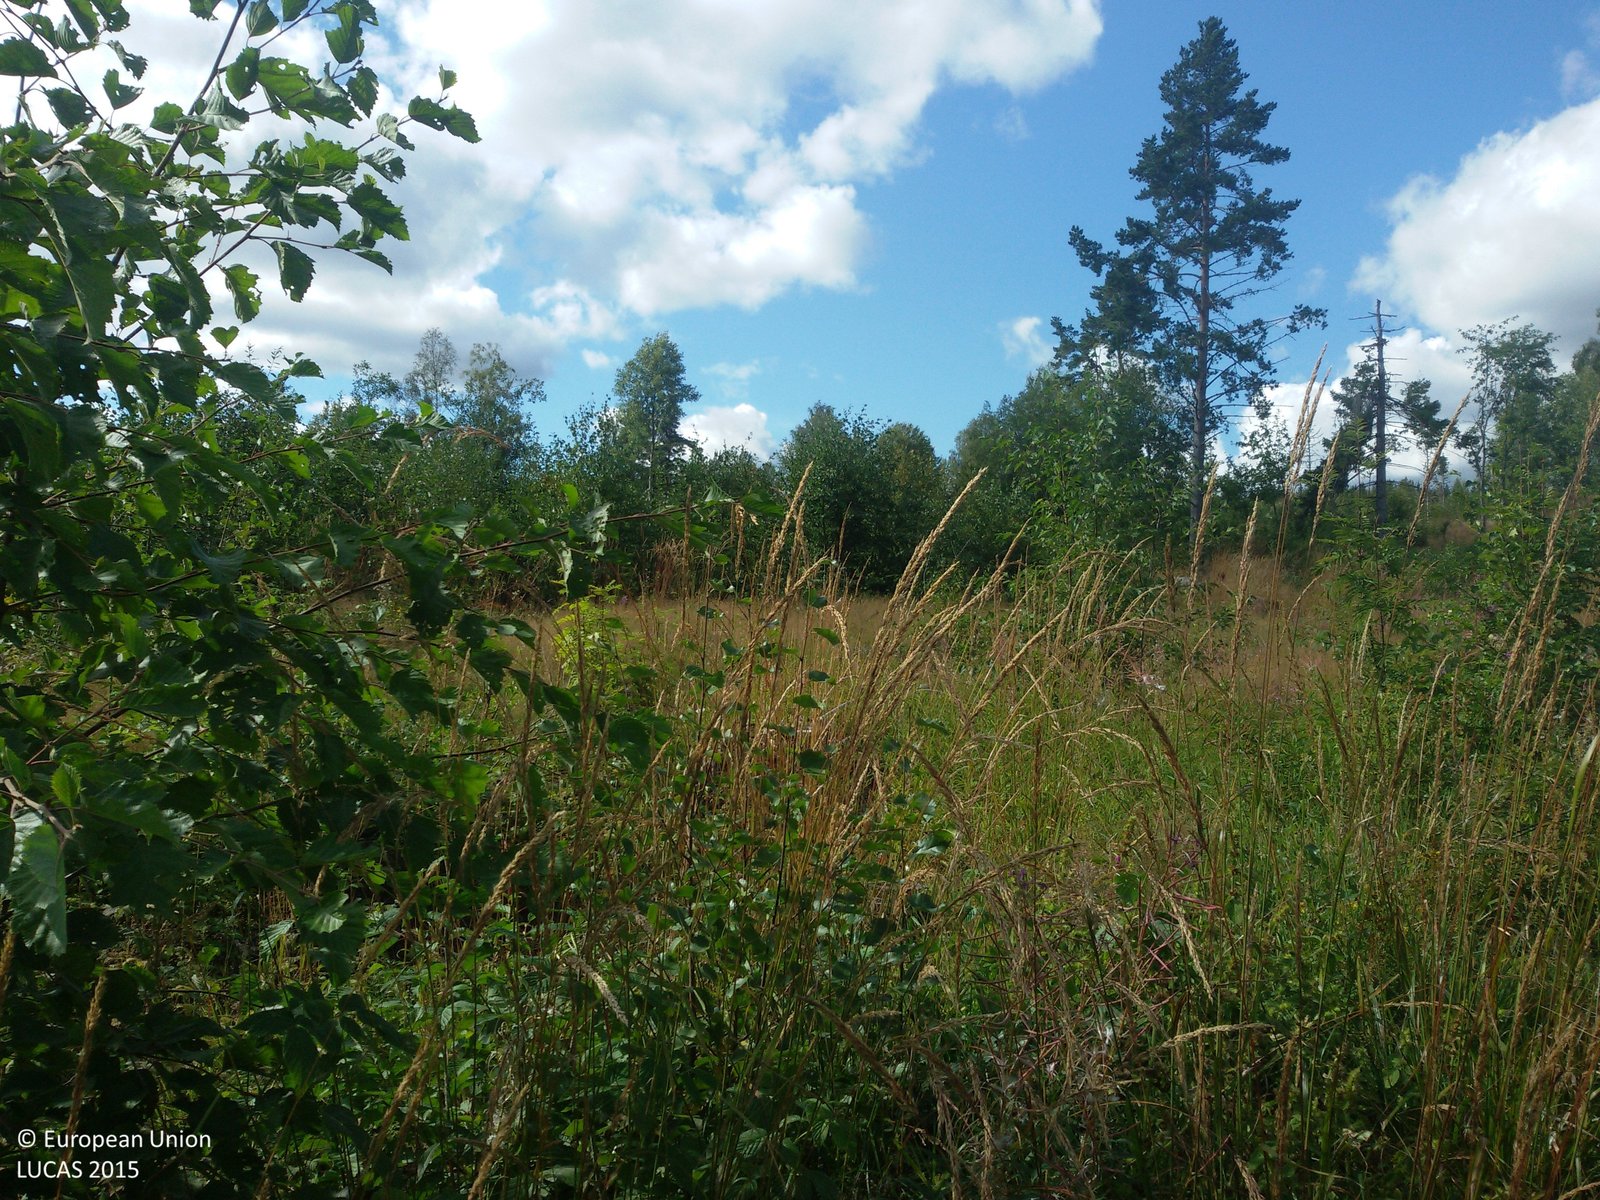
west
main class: Woodland
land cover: Broadleaved woodland
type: boreal forest
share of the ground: 10 - 25 %
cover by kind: herbaceous plants 60 %, shrubs 30 %, broadleaved forest trees 10 %
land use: Forestry
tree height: < 5 m
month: August
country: SE
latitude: 60.7923
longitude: 16.0309
